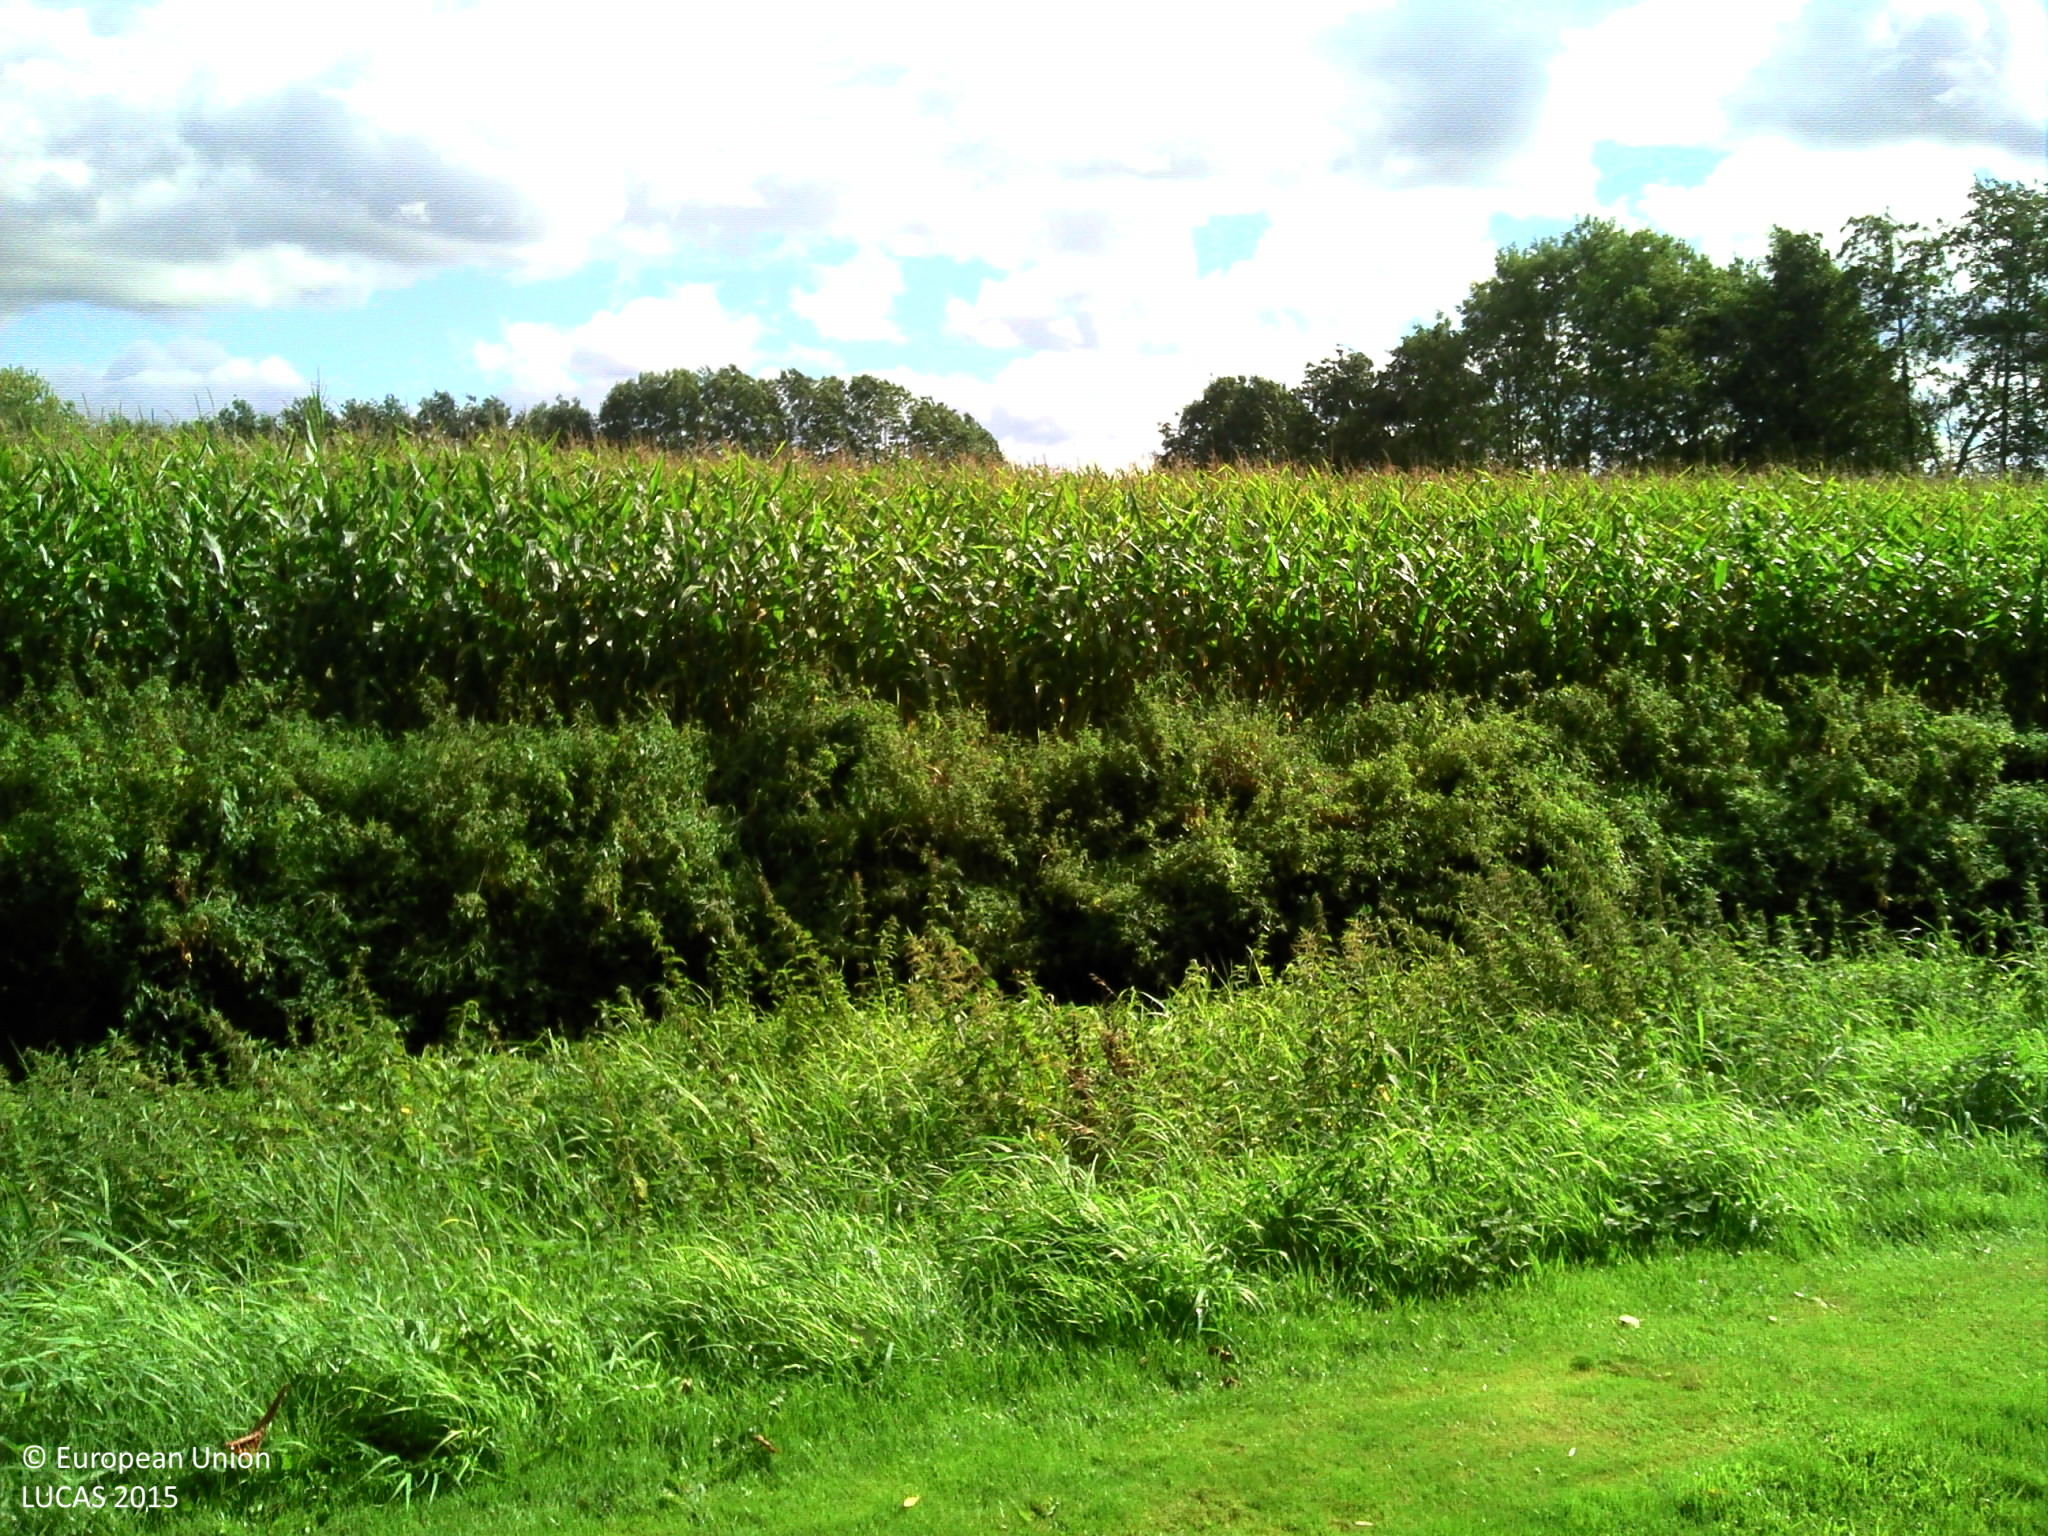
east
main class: Grassland
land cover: Grassland without tree/shrub cover
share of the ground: > 75 %
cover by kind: herbaceous plants 100 %
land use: Residential
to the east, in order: Grassland without tree/shrub cover; Grass margins; Inland fresh running water; Grassland without tree/shrub cover; Maize; Lines of trees; Grass margins; Tracks; Grass margins; Managed hedges; Nurseries; Ditches and canals; Artificial constructions in urban areas; Nurseries
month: September
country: BE
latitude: 51.4744
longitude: 4.4815
